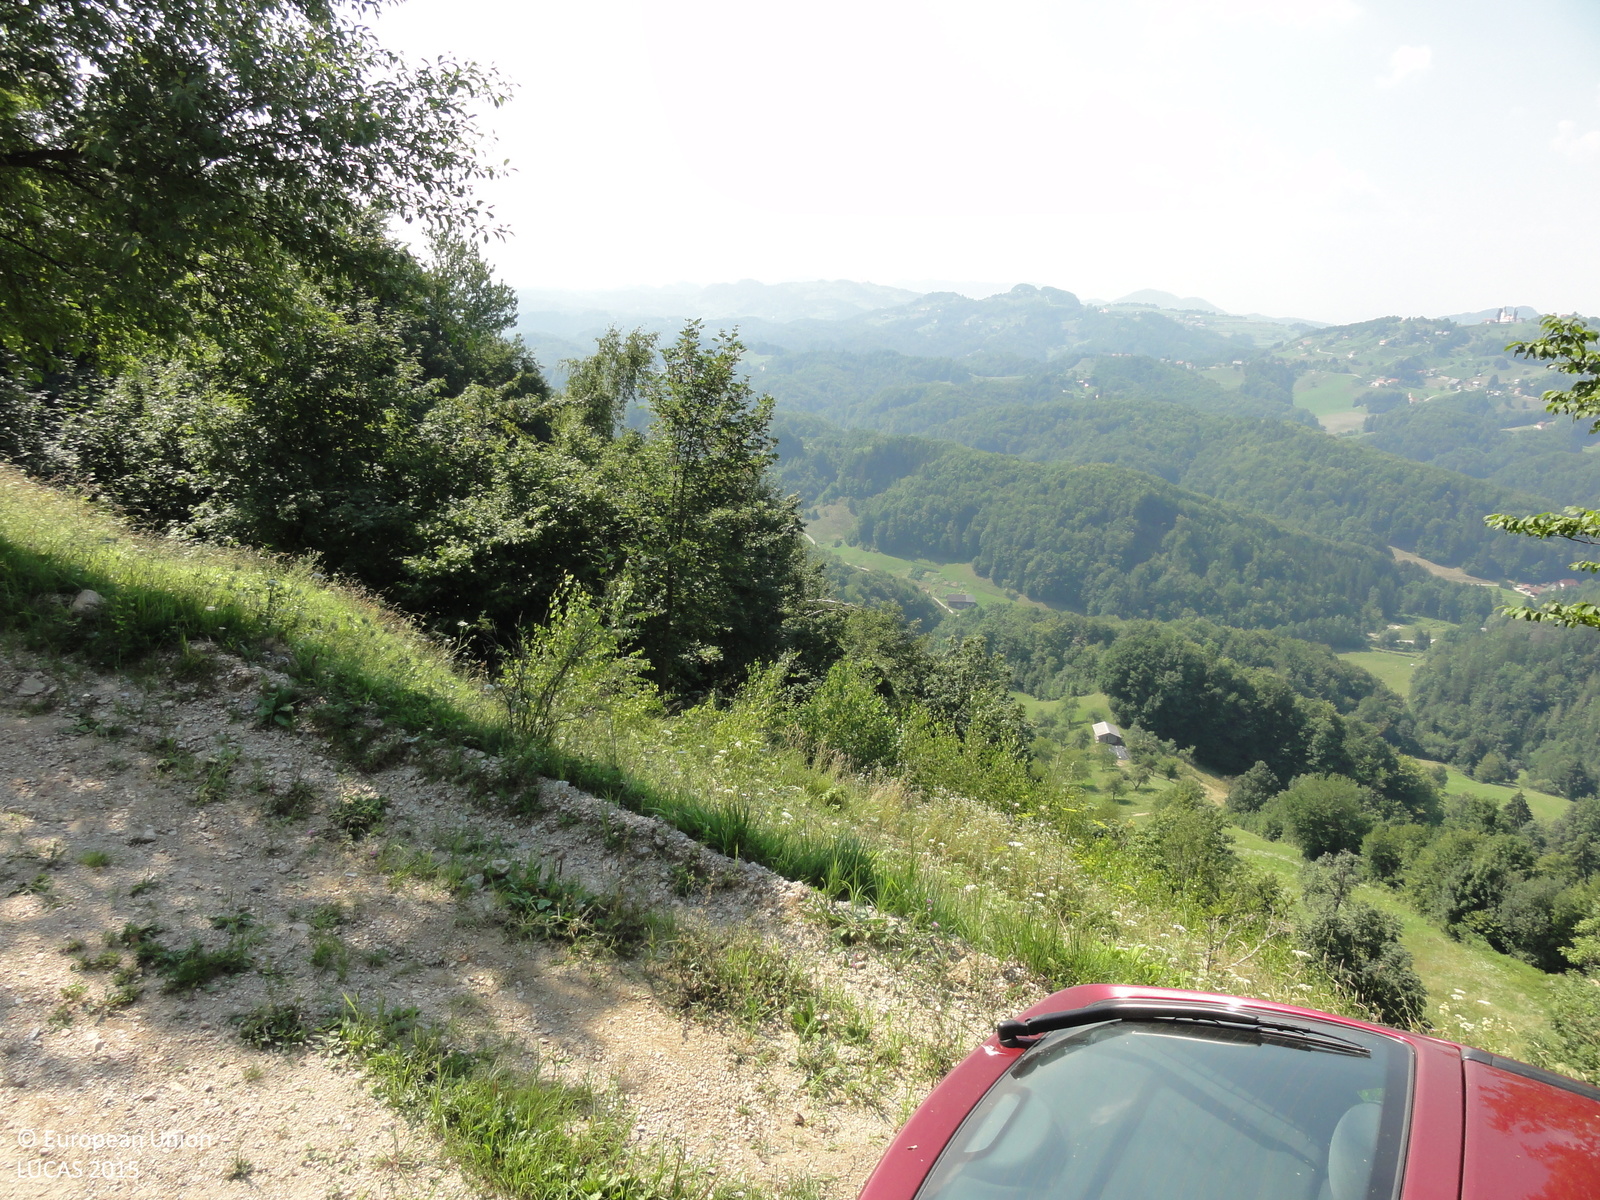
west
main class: Grassland
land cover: Grassland without tree/shrub cover
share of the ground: > 75 %
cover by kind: herbaceous plants 100 %
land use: Agriculture (excluding fallow land and kitchen gardens)
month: August
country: SI
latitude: 46.1568
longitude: 15.4753
